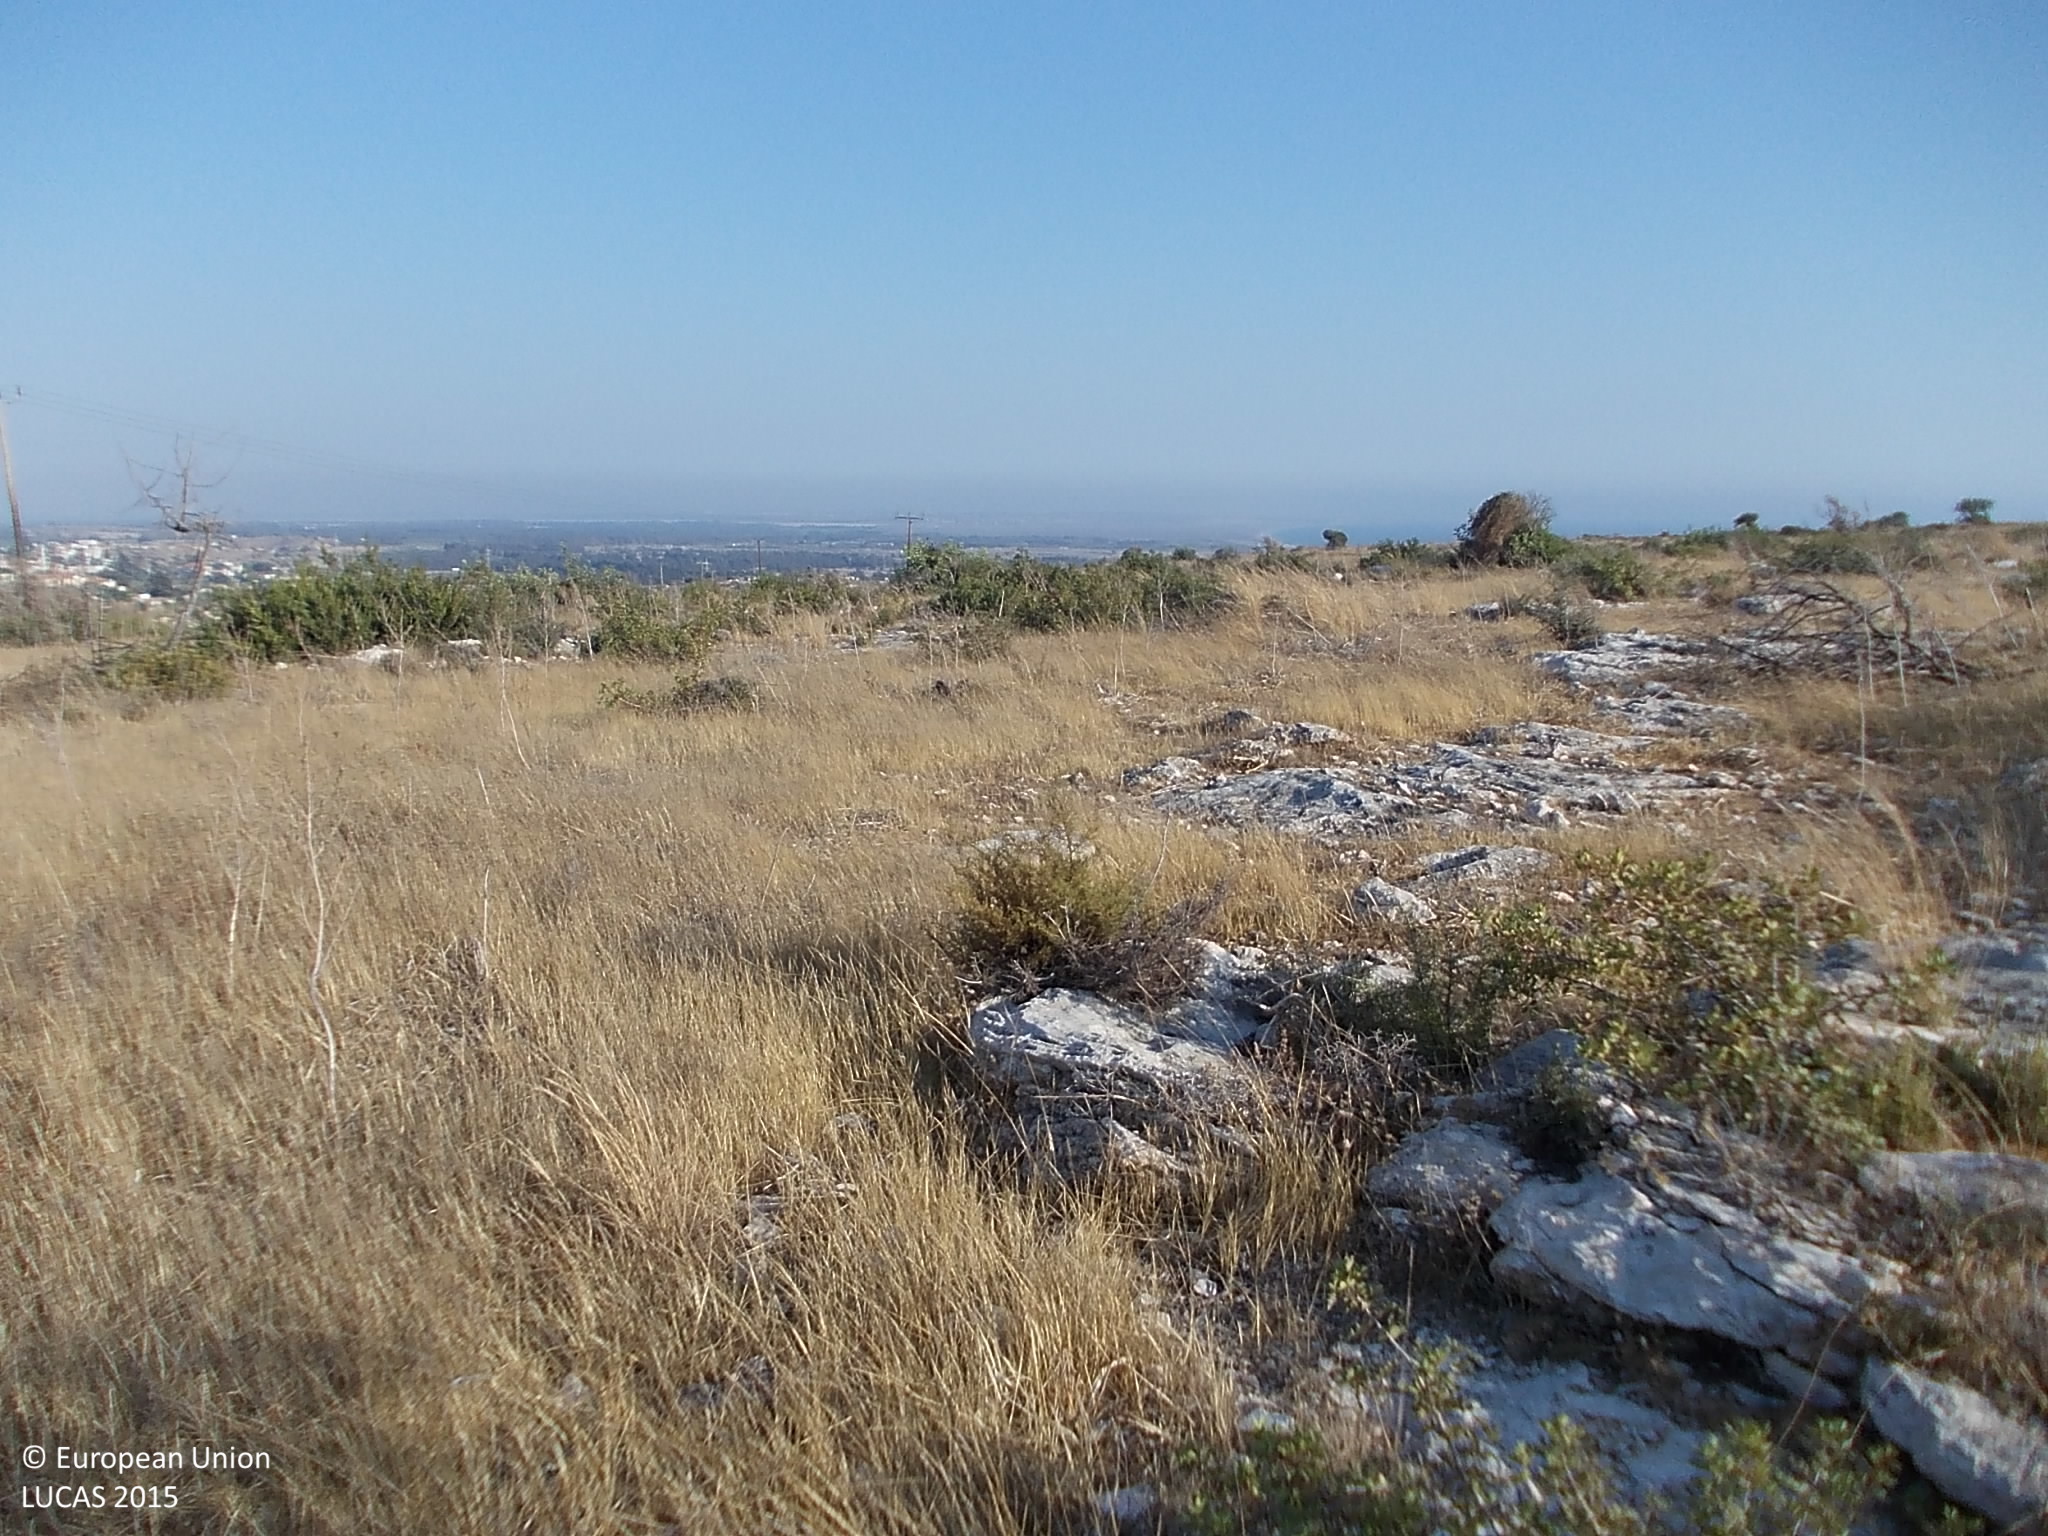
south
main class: Shrubland
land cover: Shrubland without tree cover
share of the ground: 25 - 50 %
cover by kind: herbaceous plants 50 %, shrubs 40 %, unconsolidated bare surface 10 %
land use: Semi-natural and natural areas not in use
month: September
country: CY
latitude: 34.6718
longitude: 32.8912
